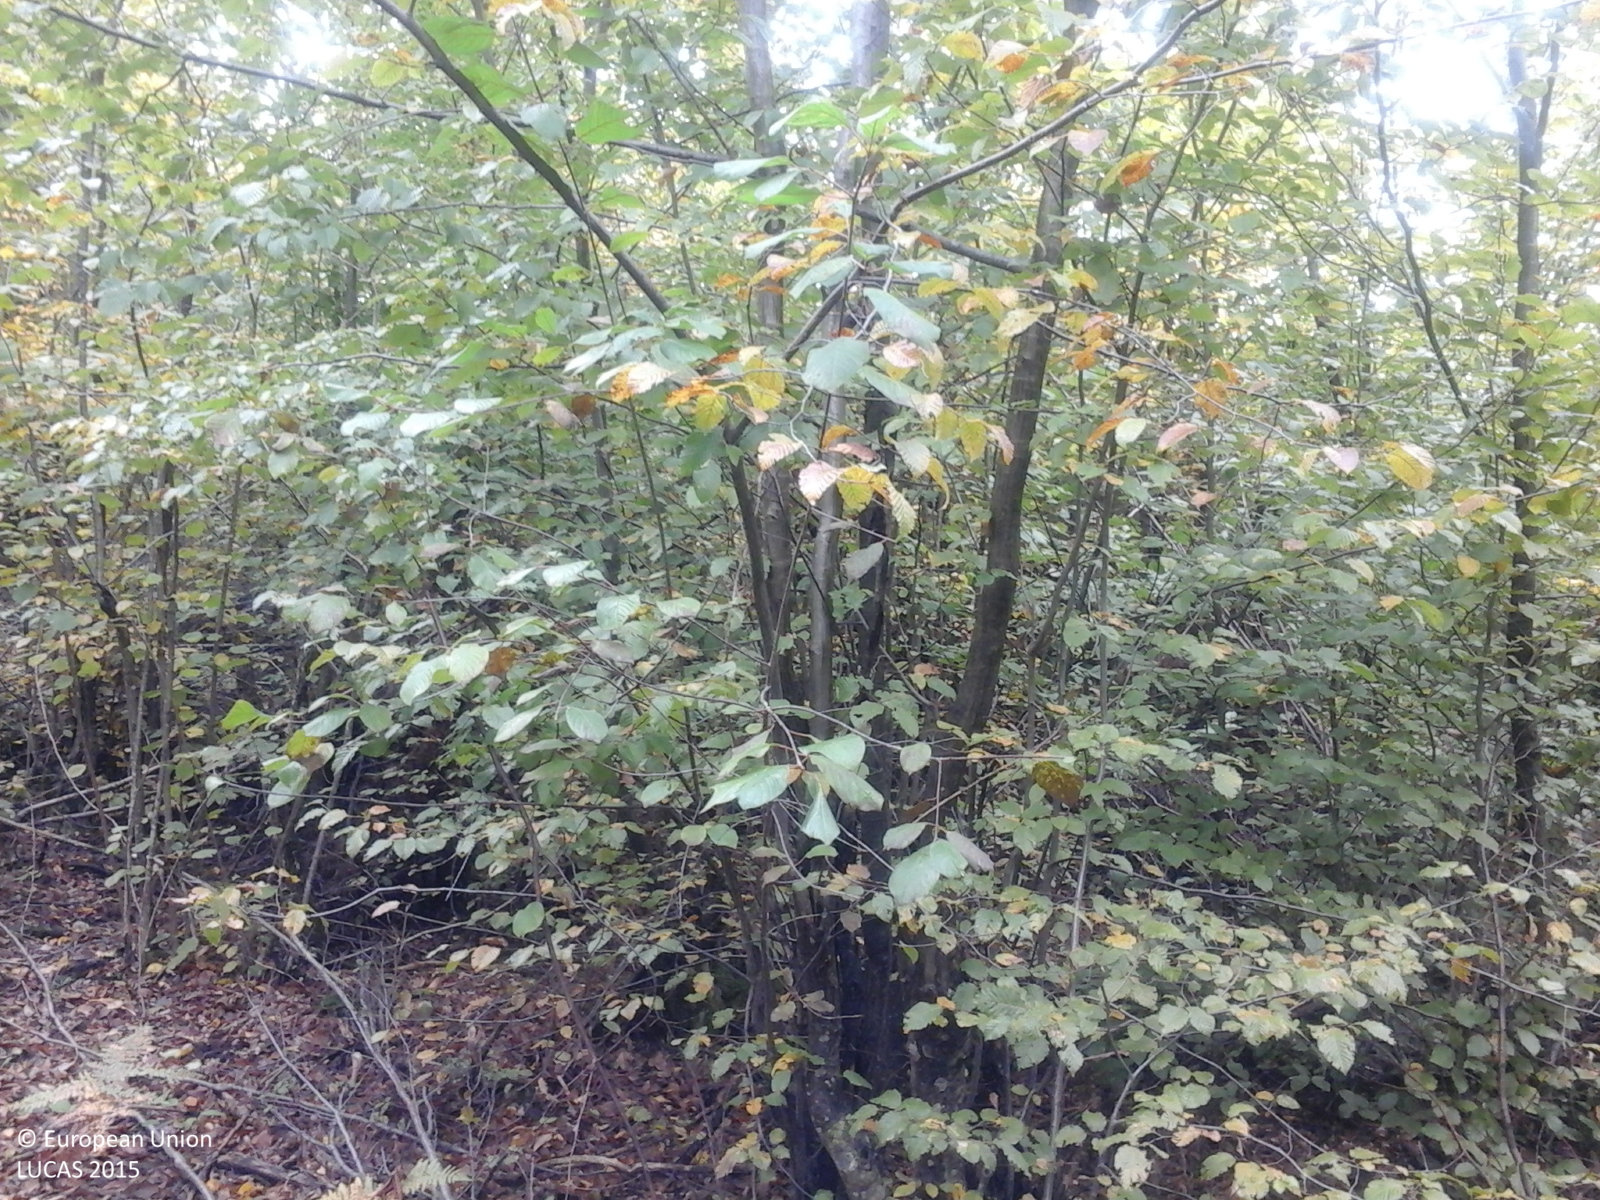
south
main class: Woodland
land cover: Broadleaved woodland
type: beech forest
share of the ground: > 75 %
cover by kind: broadleaved forest trees 100 %
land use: Forestry
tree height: > 5 m
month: October
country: RO
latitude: 45.7028
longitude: 25.0295
